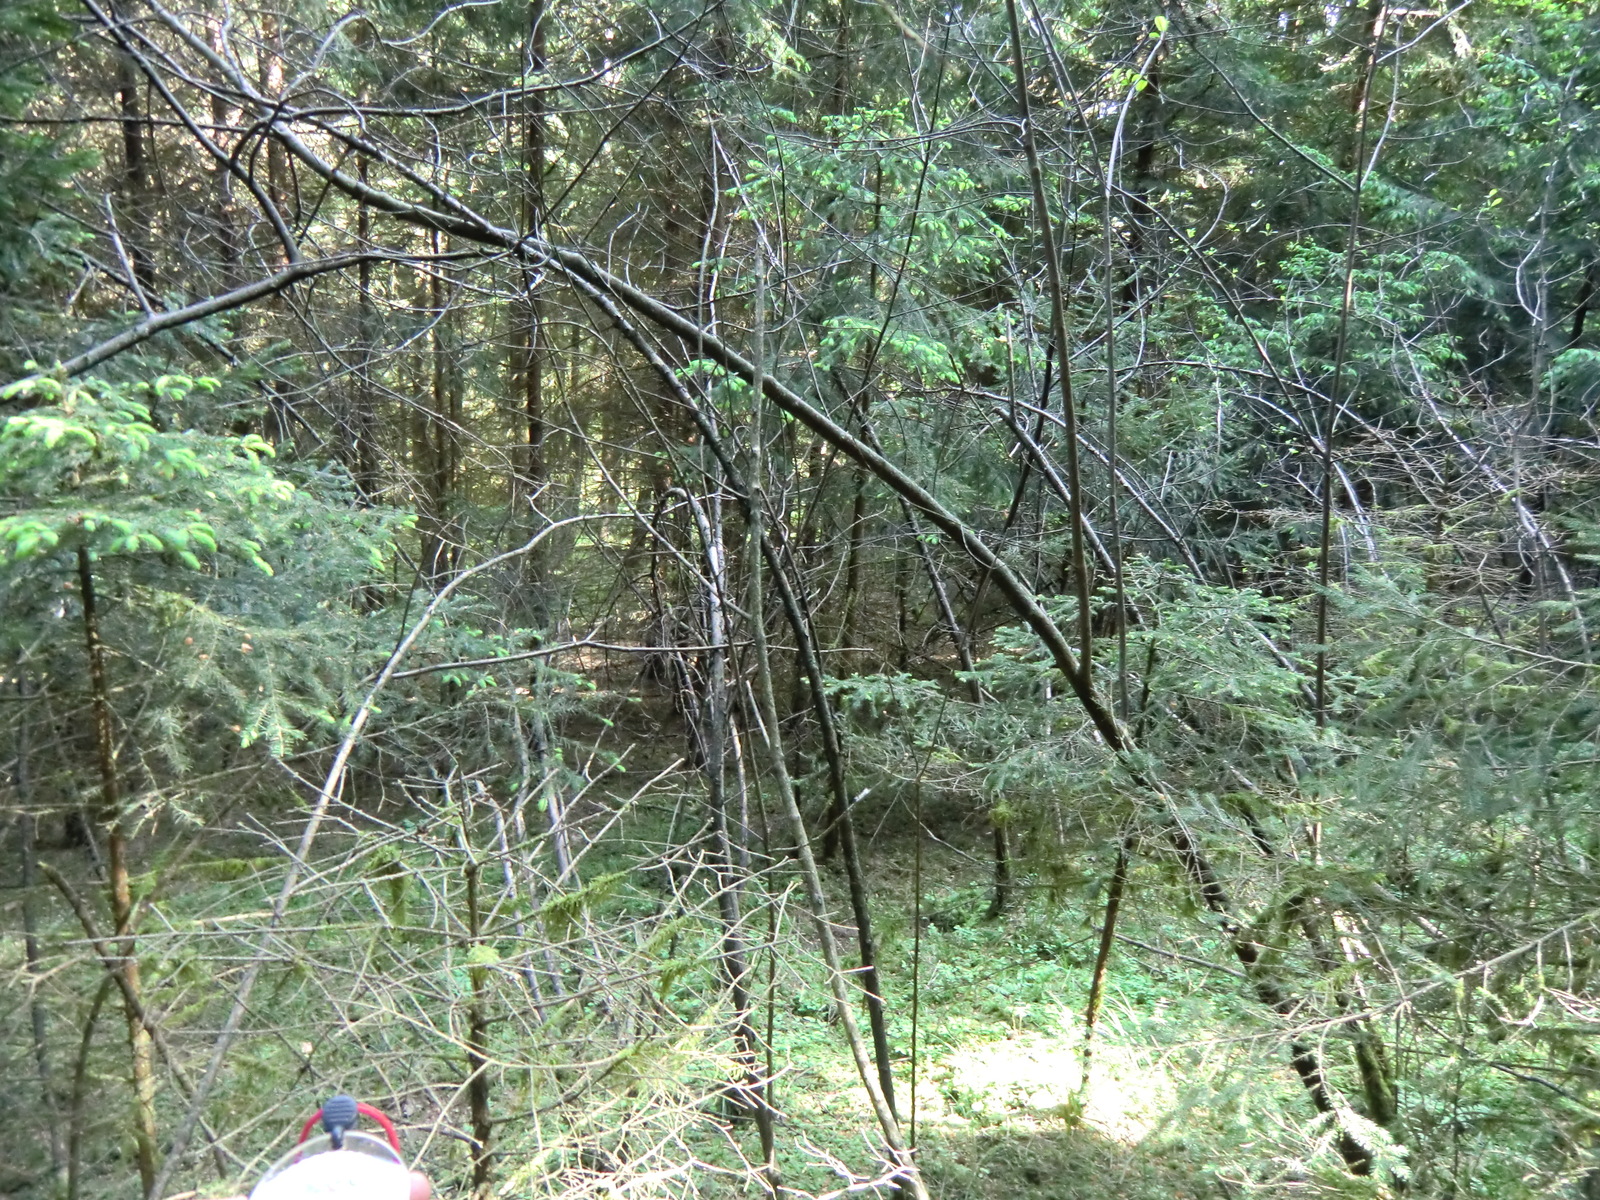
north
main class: Woodland
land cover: Spruce dominated coniferous woodland
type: alpine coniferous forest
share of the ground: > 75 %
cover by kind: coniferous forest trees 70 %, unconsolidated bare surface 30 %
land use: Forestry
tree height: > 5 m
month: May
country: AT
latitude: 48.3335
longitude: 14.4115
